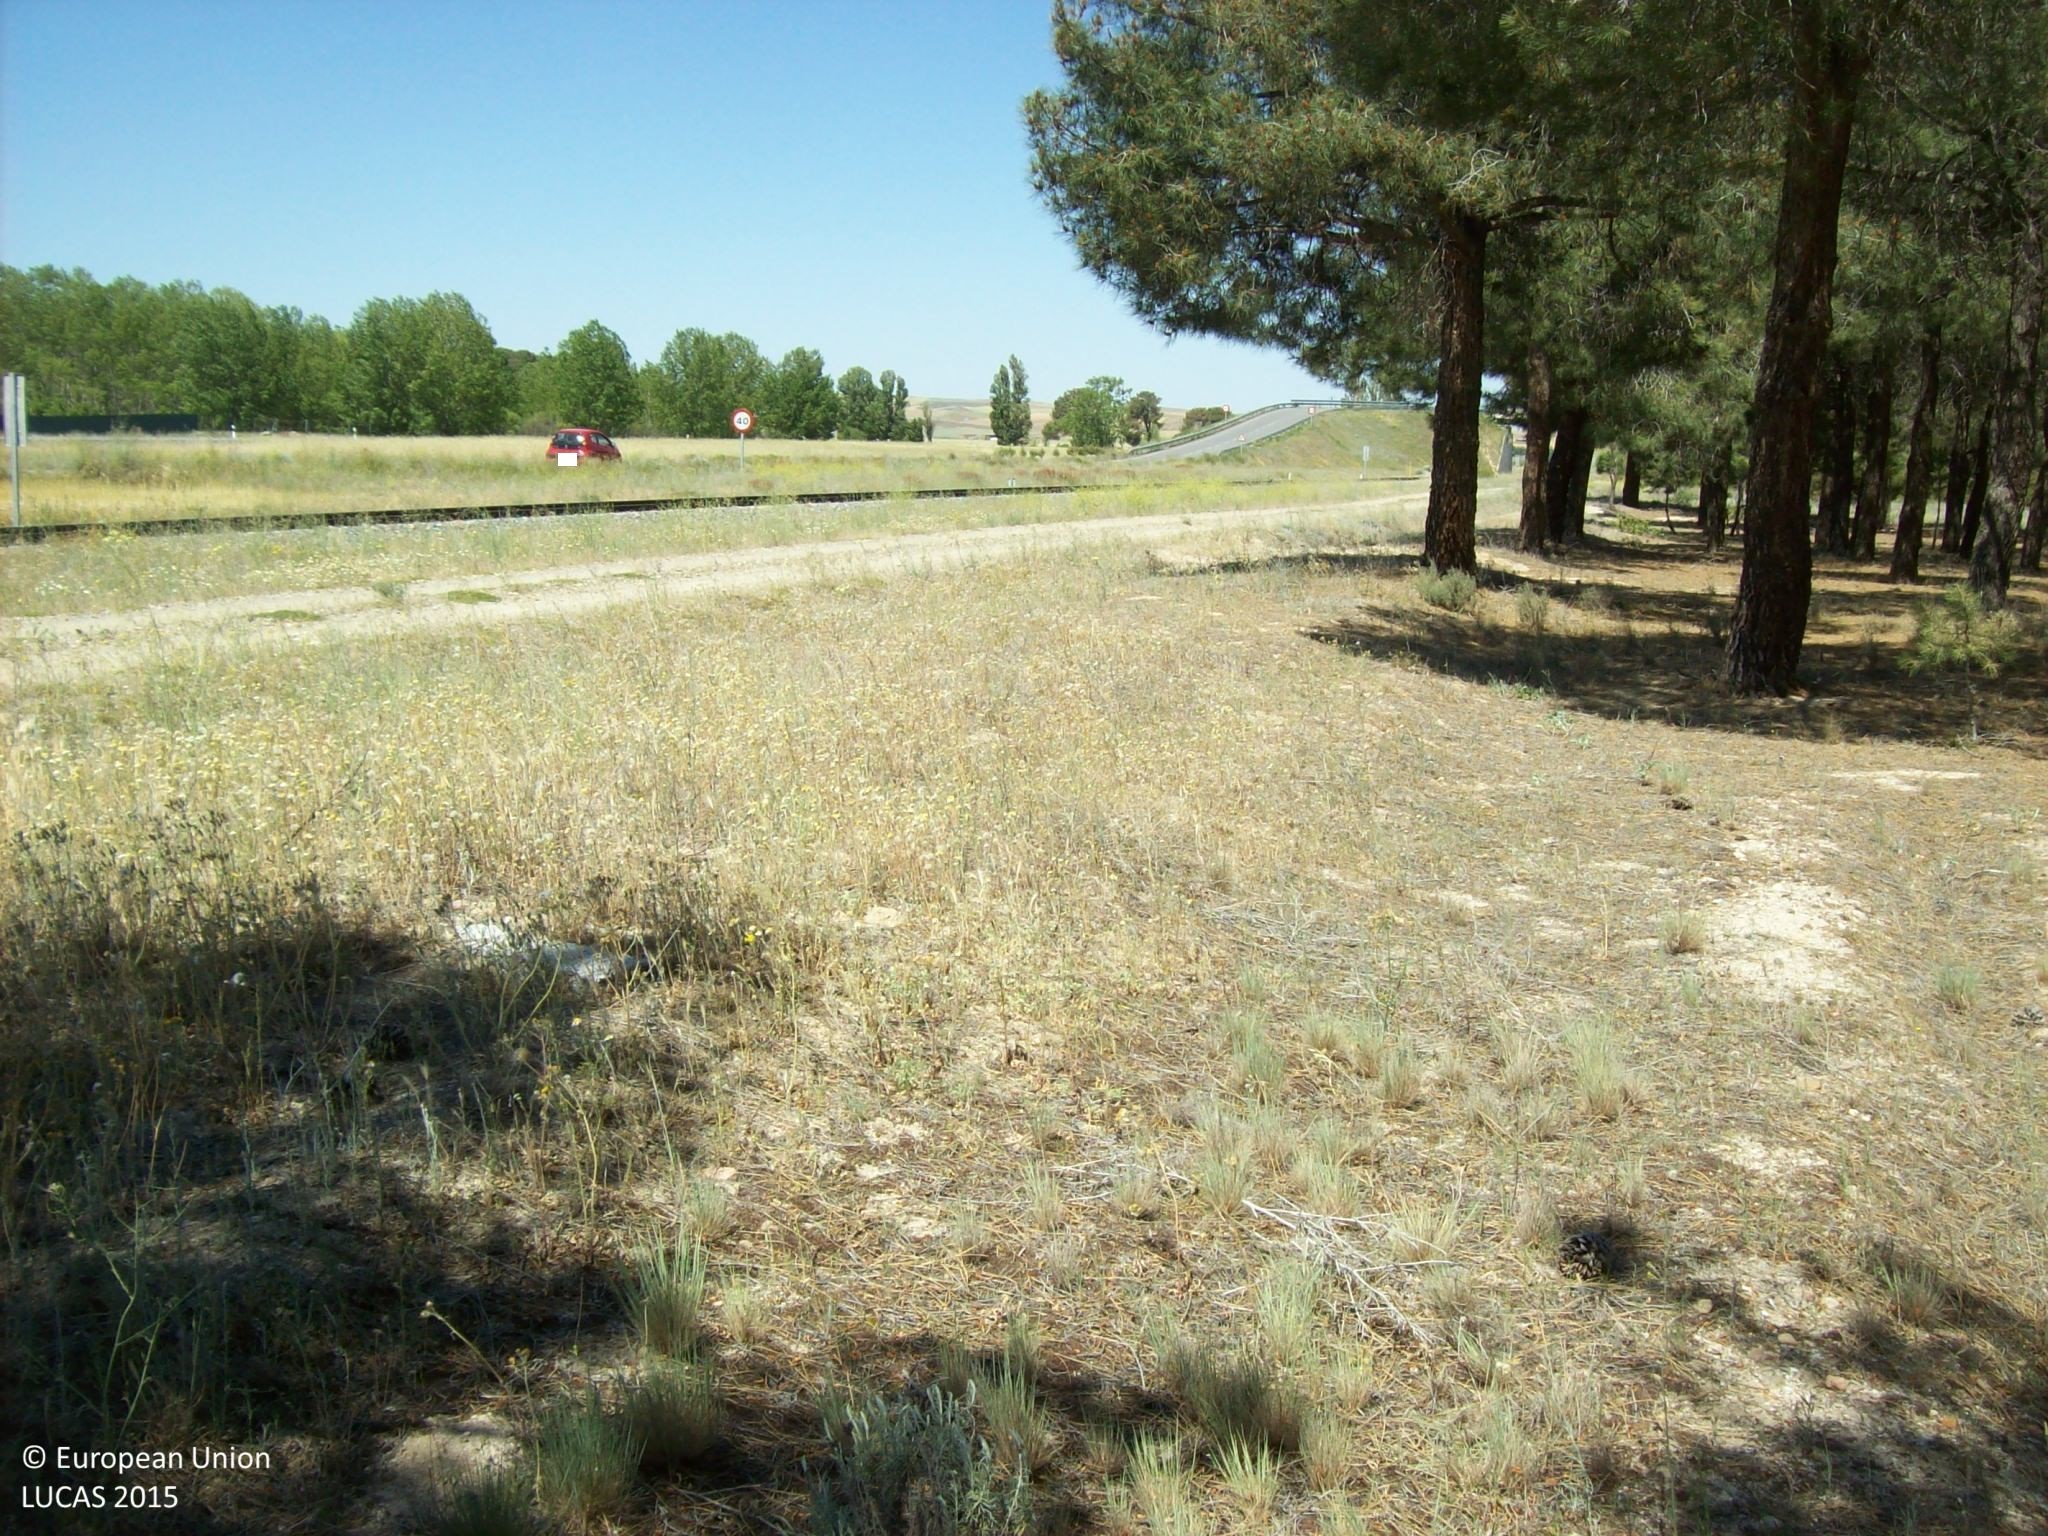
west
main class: Woodland
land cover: Pine dominated coniferous woodland
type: coniferous forest of the mediterranean region
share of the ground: 25 - 50 %
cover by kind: unconsolidated bare surface 50 %, coniferous forest trees 30 %, herbaceous plants 10 %
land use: Forestry
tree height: < 5 m
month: May
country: ES
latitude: 40.8125
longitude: -4.8915
